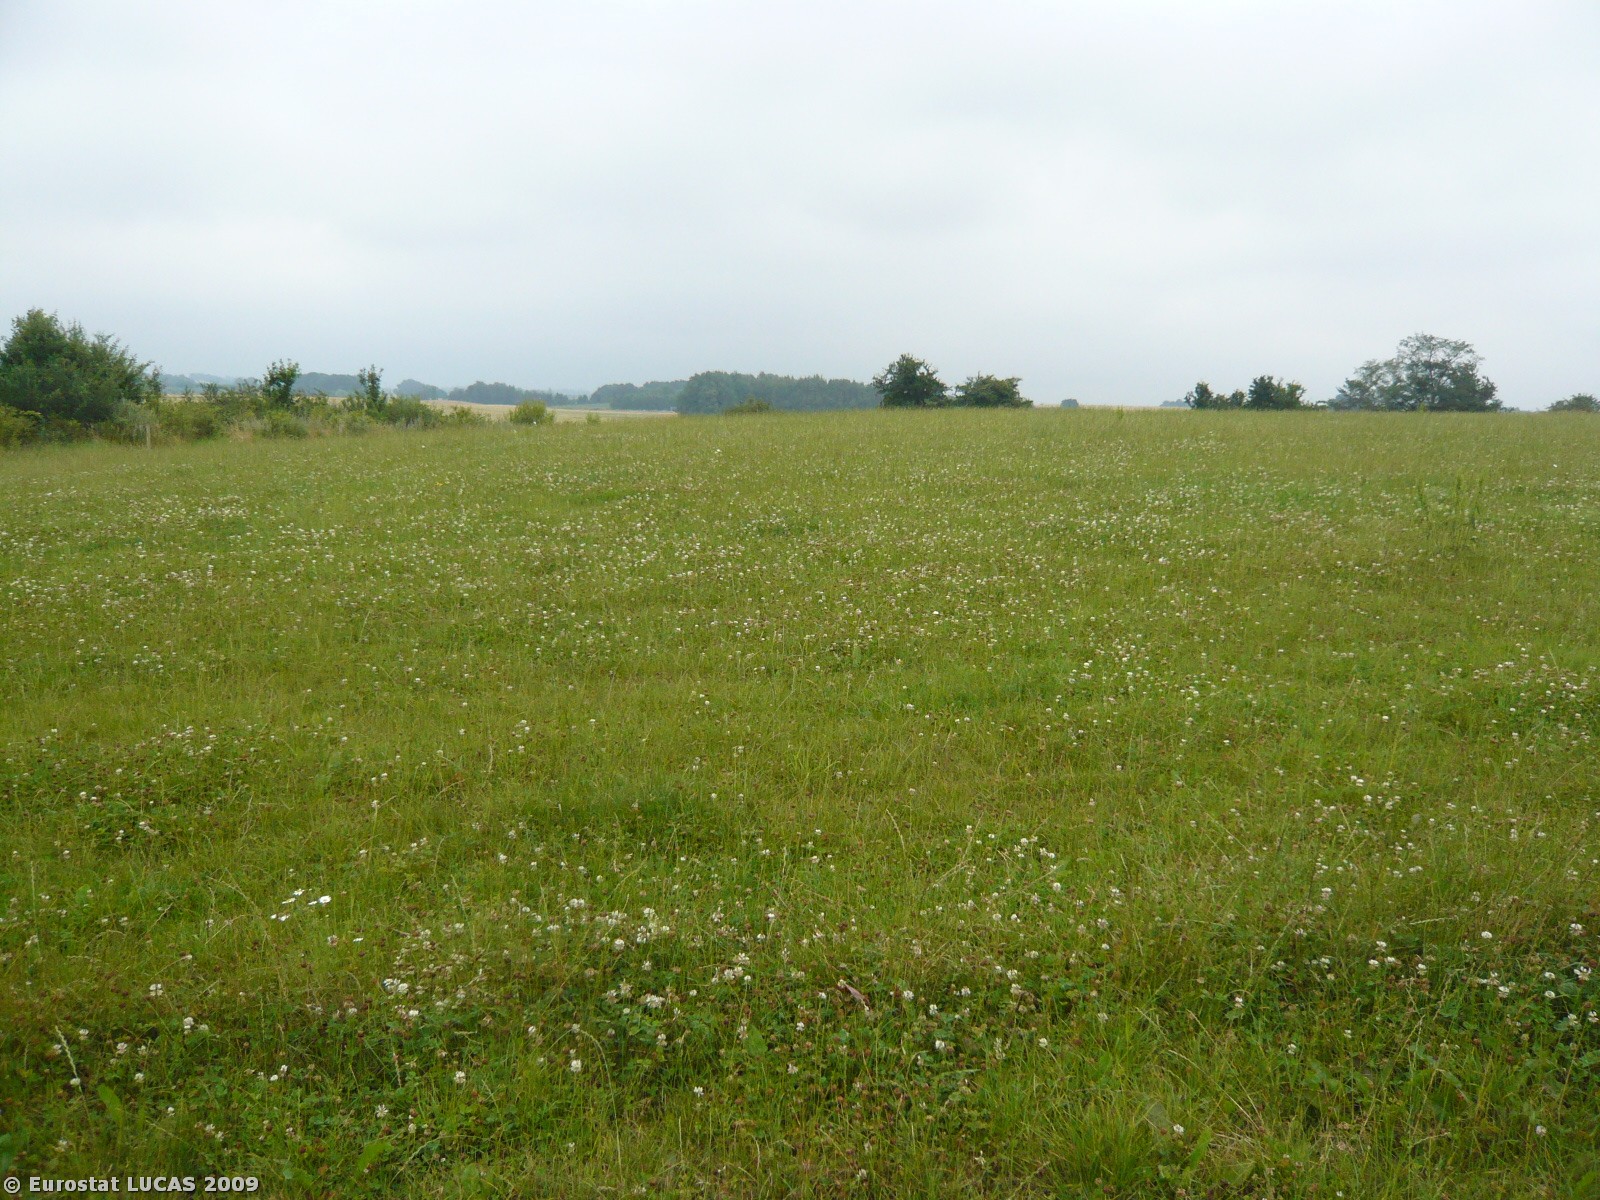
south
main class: Grassland
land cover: Grassland without tree/shrub cover
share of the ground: > 75 %
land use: Agriculture (excluding fallow land and kitchen gardens)
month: July
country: DK
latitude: 55.7767
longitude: 11.9910
